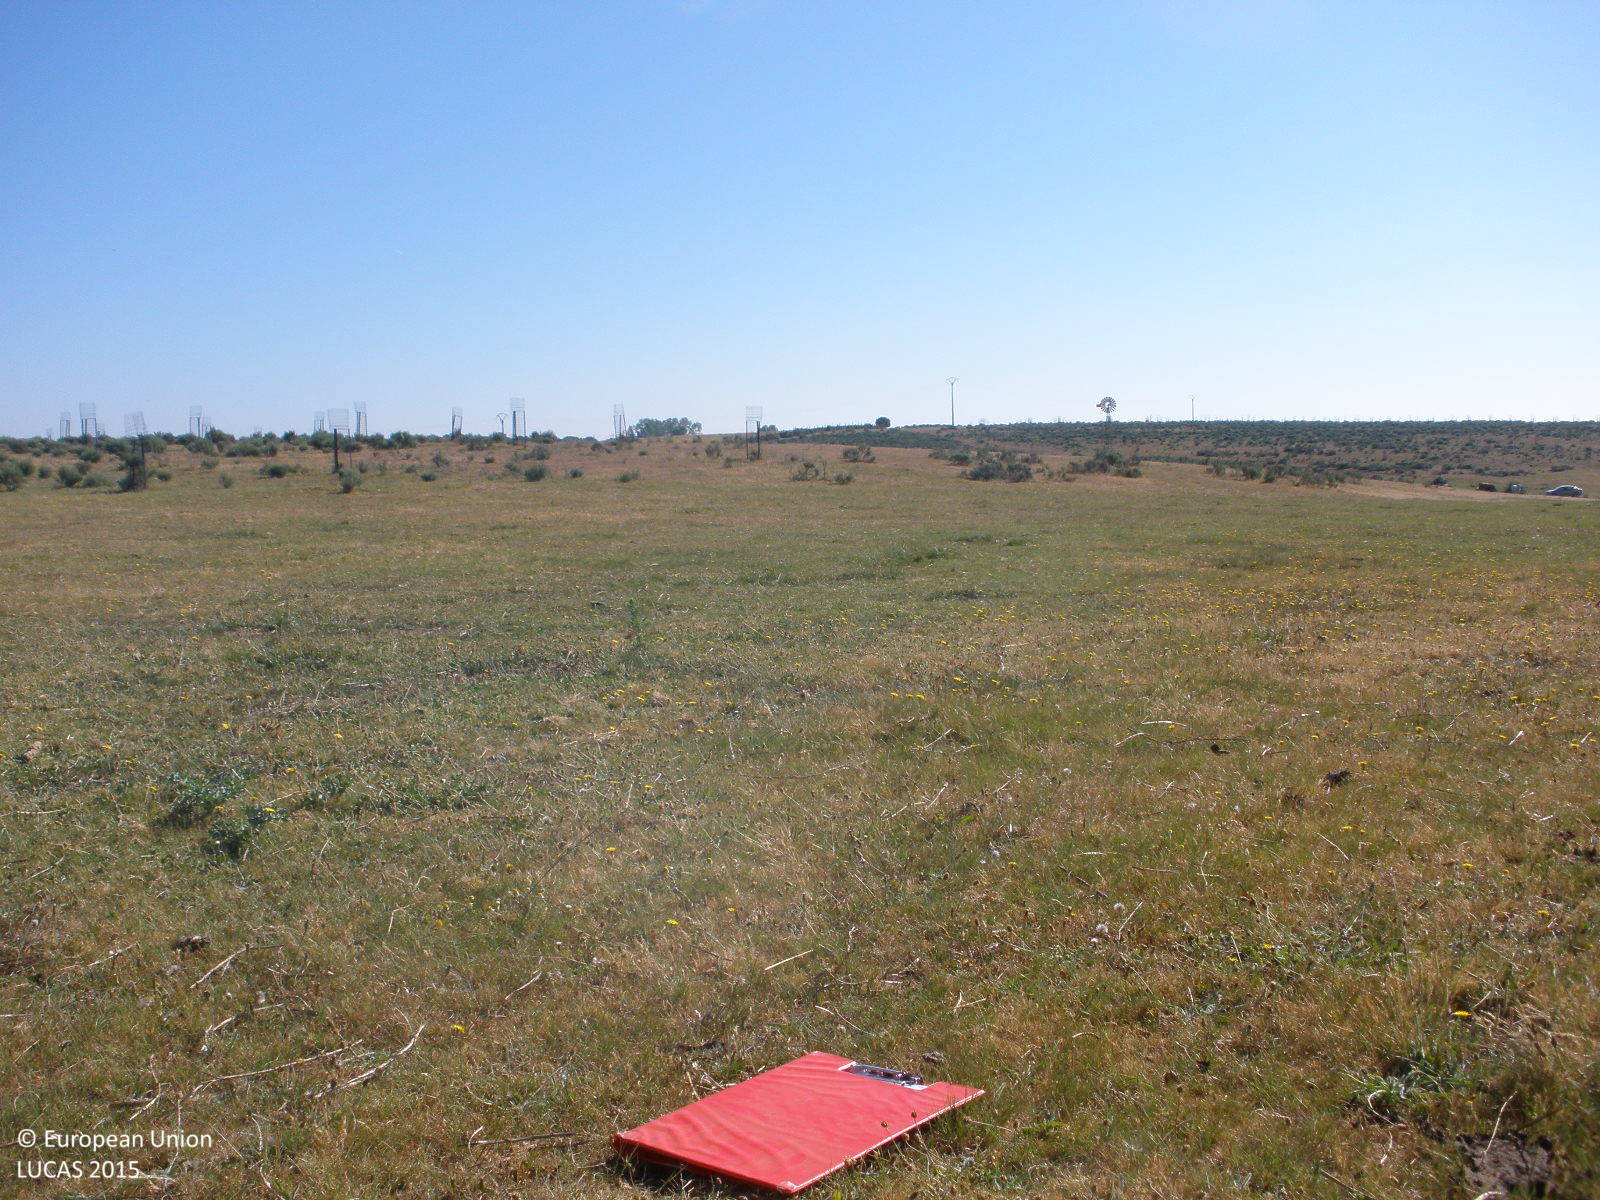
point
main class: Grassland
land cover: Grassland without tree/shrub cover
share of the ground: > 75 %
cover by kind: herbaceous plants 100 %
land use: Agriculture (excluding fallow land and kitchen gardens)
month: June
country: ES
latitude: 40.4356
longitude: -6.6527
